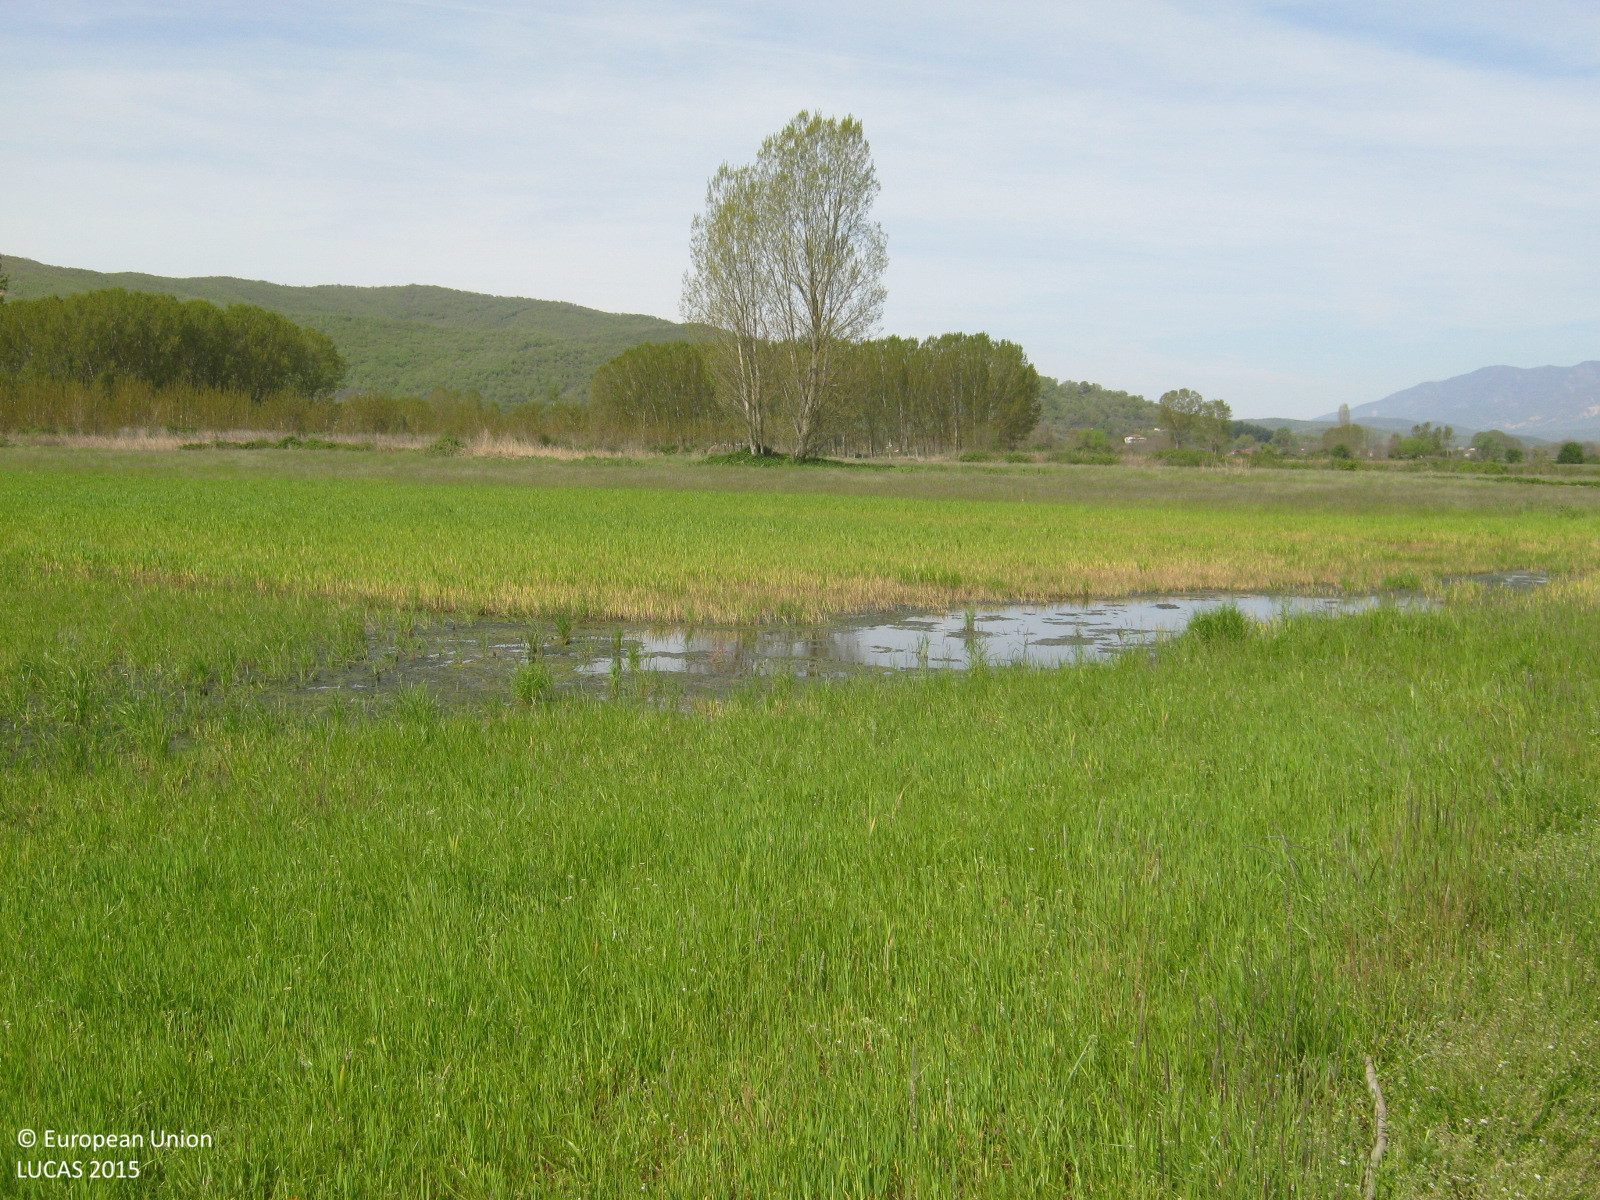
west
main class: Cropland
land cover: Barley
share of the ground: > 75 %
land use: Agriculture (excluding fallow land and kitchen gardens)
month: April
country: GR
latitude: 41.2205
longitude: 23.0528
